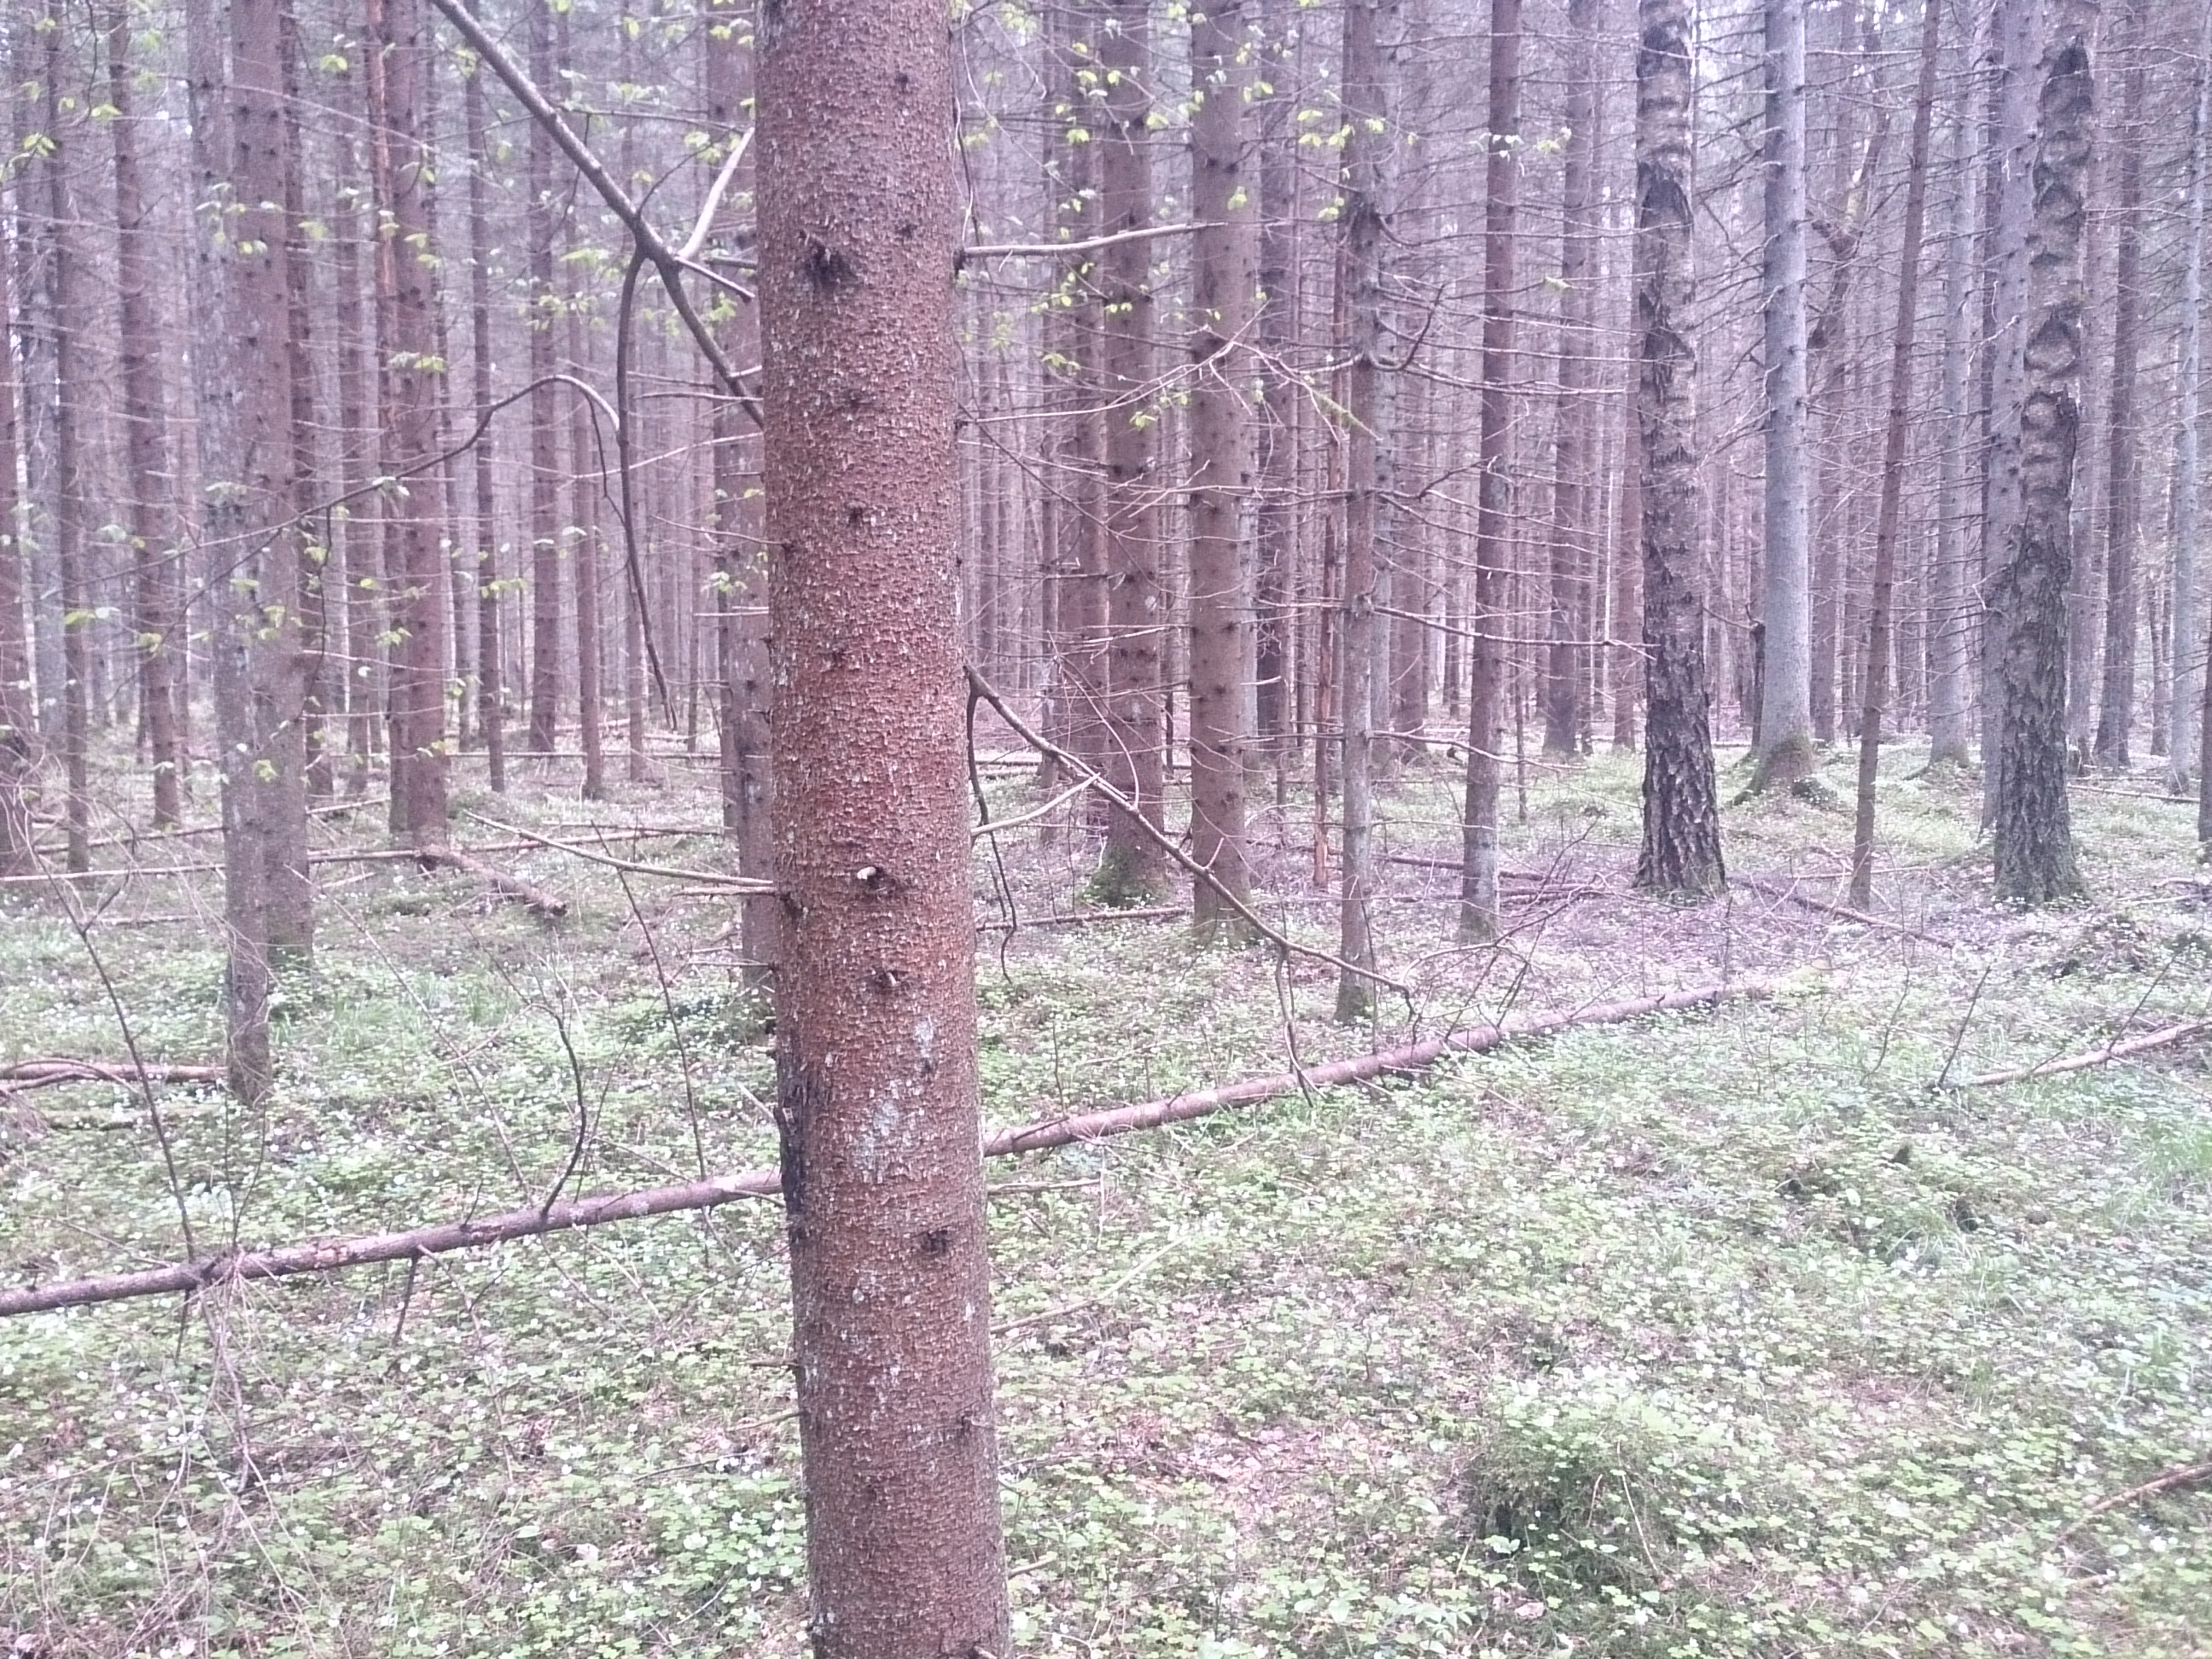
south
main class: Woodland
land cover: Spruce dominated mixed woodland
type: hemiboreal forest and nemoral coniferous forest and mixed broadleaved-coniferous forest
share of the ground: > 75 %
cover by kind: coniferous forest trees 60 %, broadleaved forest trees 40 %
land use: Forestry
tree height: > 5 m
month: May
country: LV
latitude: 56.7111
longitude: 24.0194
